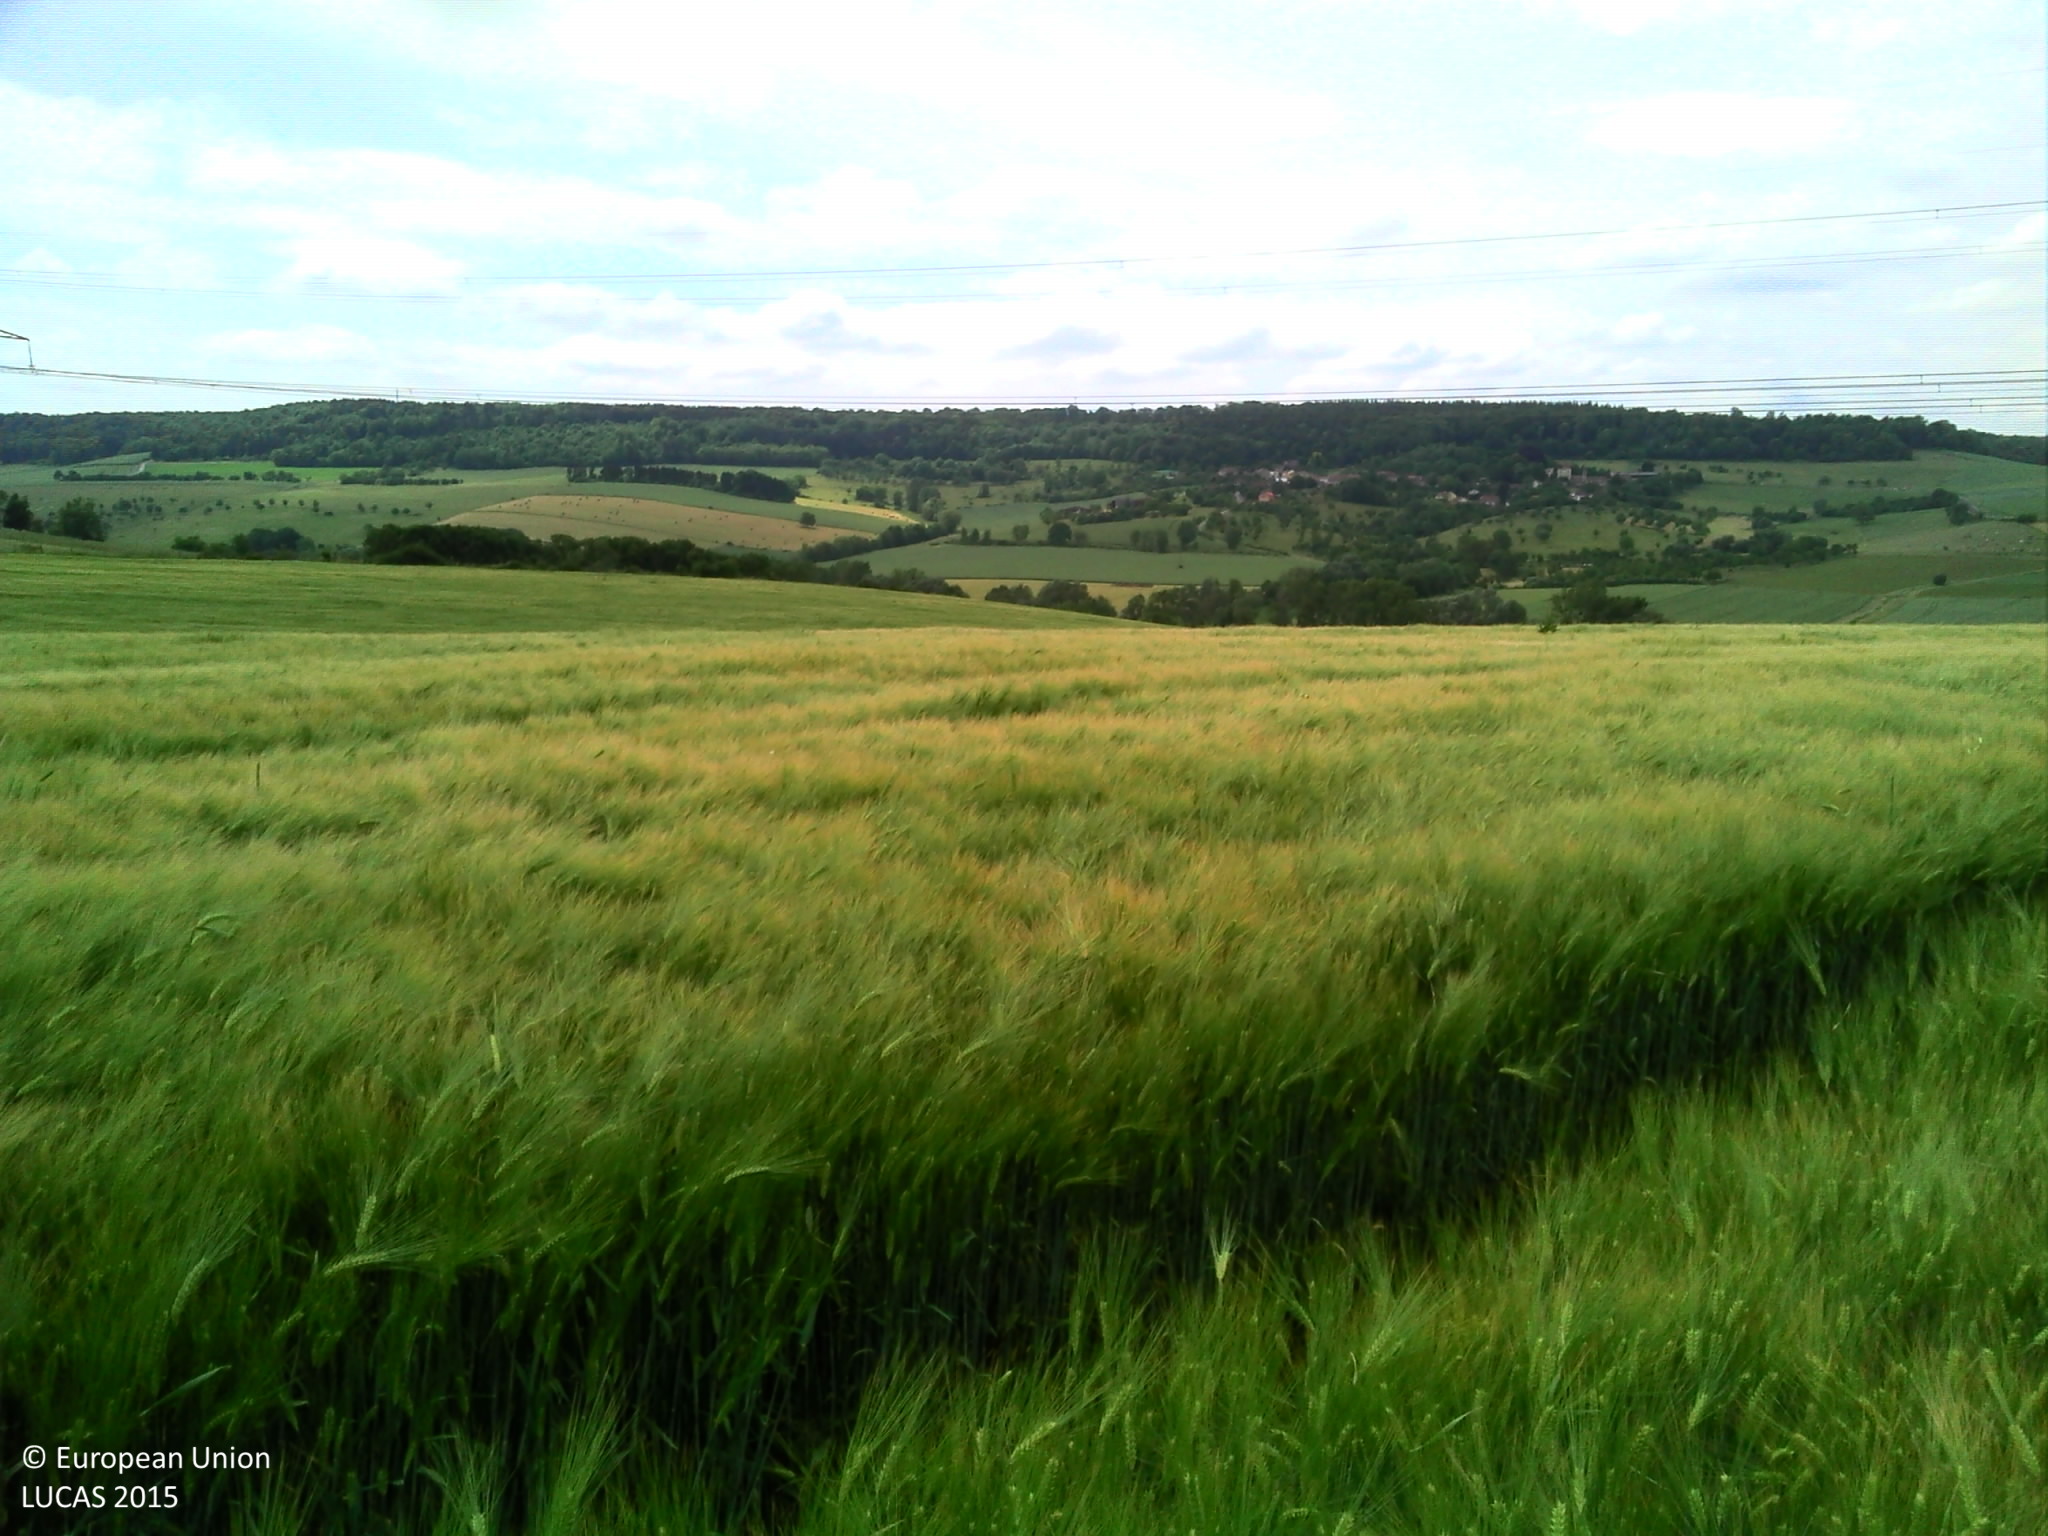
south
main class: Cropland
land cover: Barley
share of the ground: > 75 %
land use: Agriculture (excluding fallow land and kitchen gardens)
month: June
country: FR
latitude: 48.8415
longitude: 6.1711
